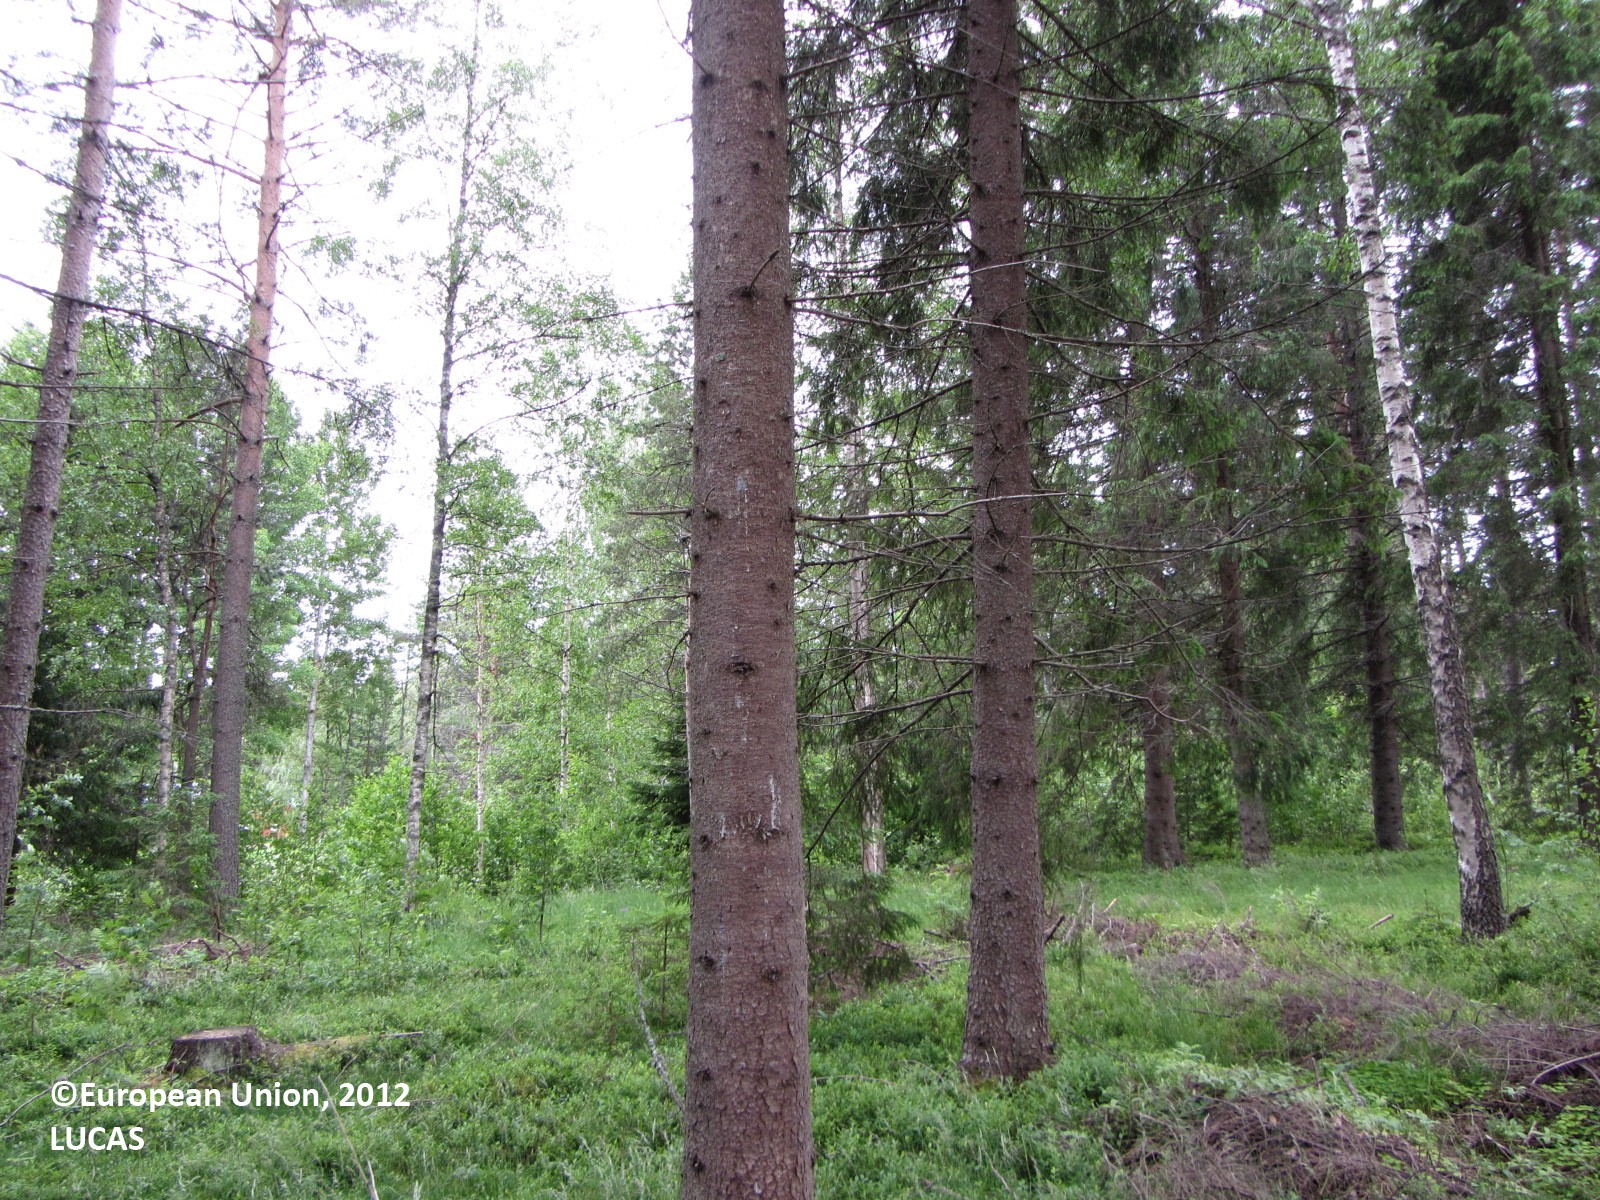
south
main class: Woodland
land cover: Spruce dominated mixed woodland
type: boreal forest
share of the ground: 50 - 75 %
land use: Forestry
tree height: > 5 m
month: June
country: FI
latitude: 62.5940
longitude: 25.5150
